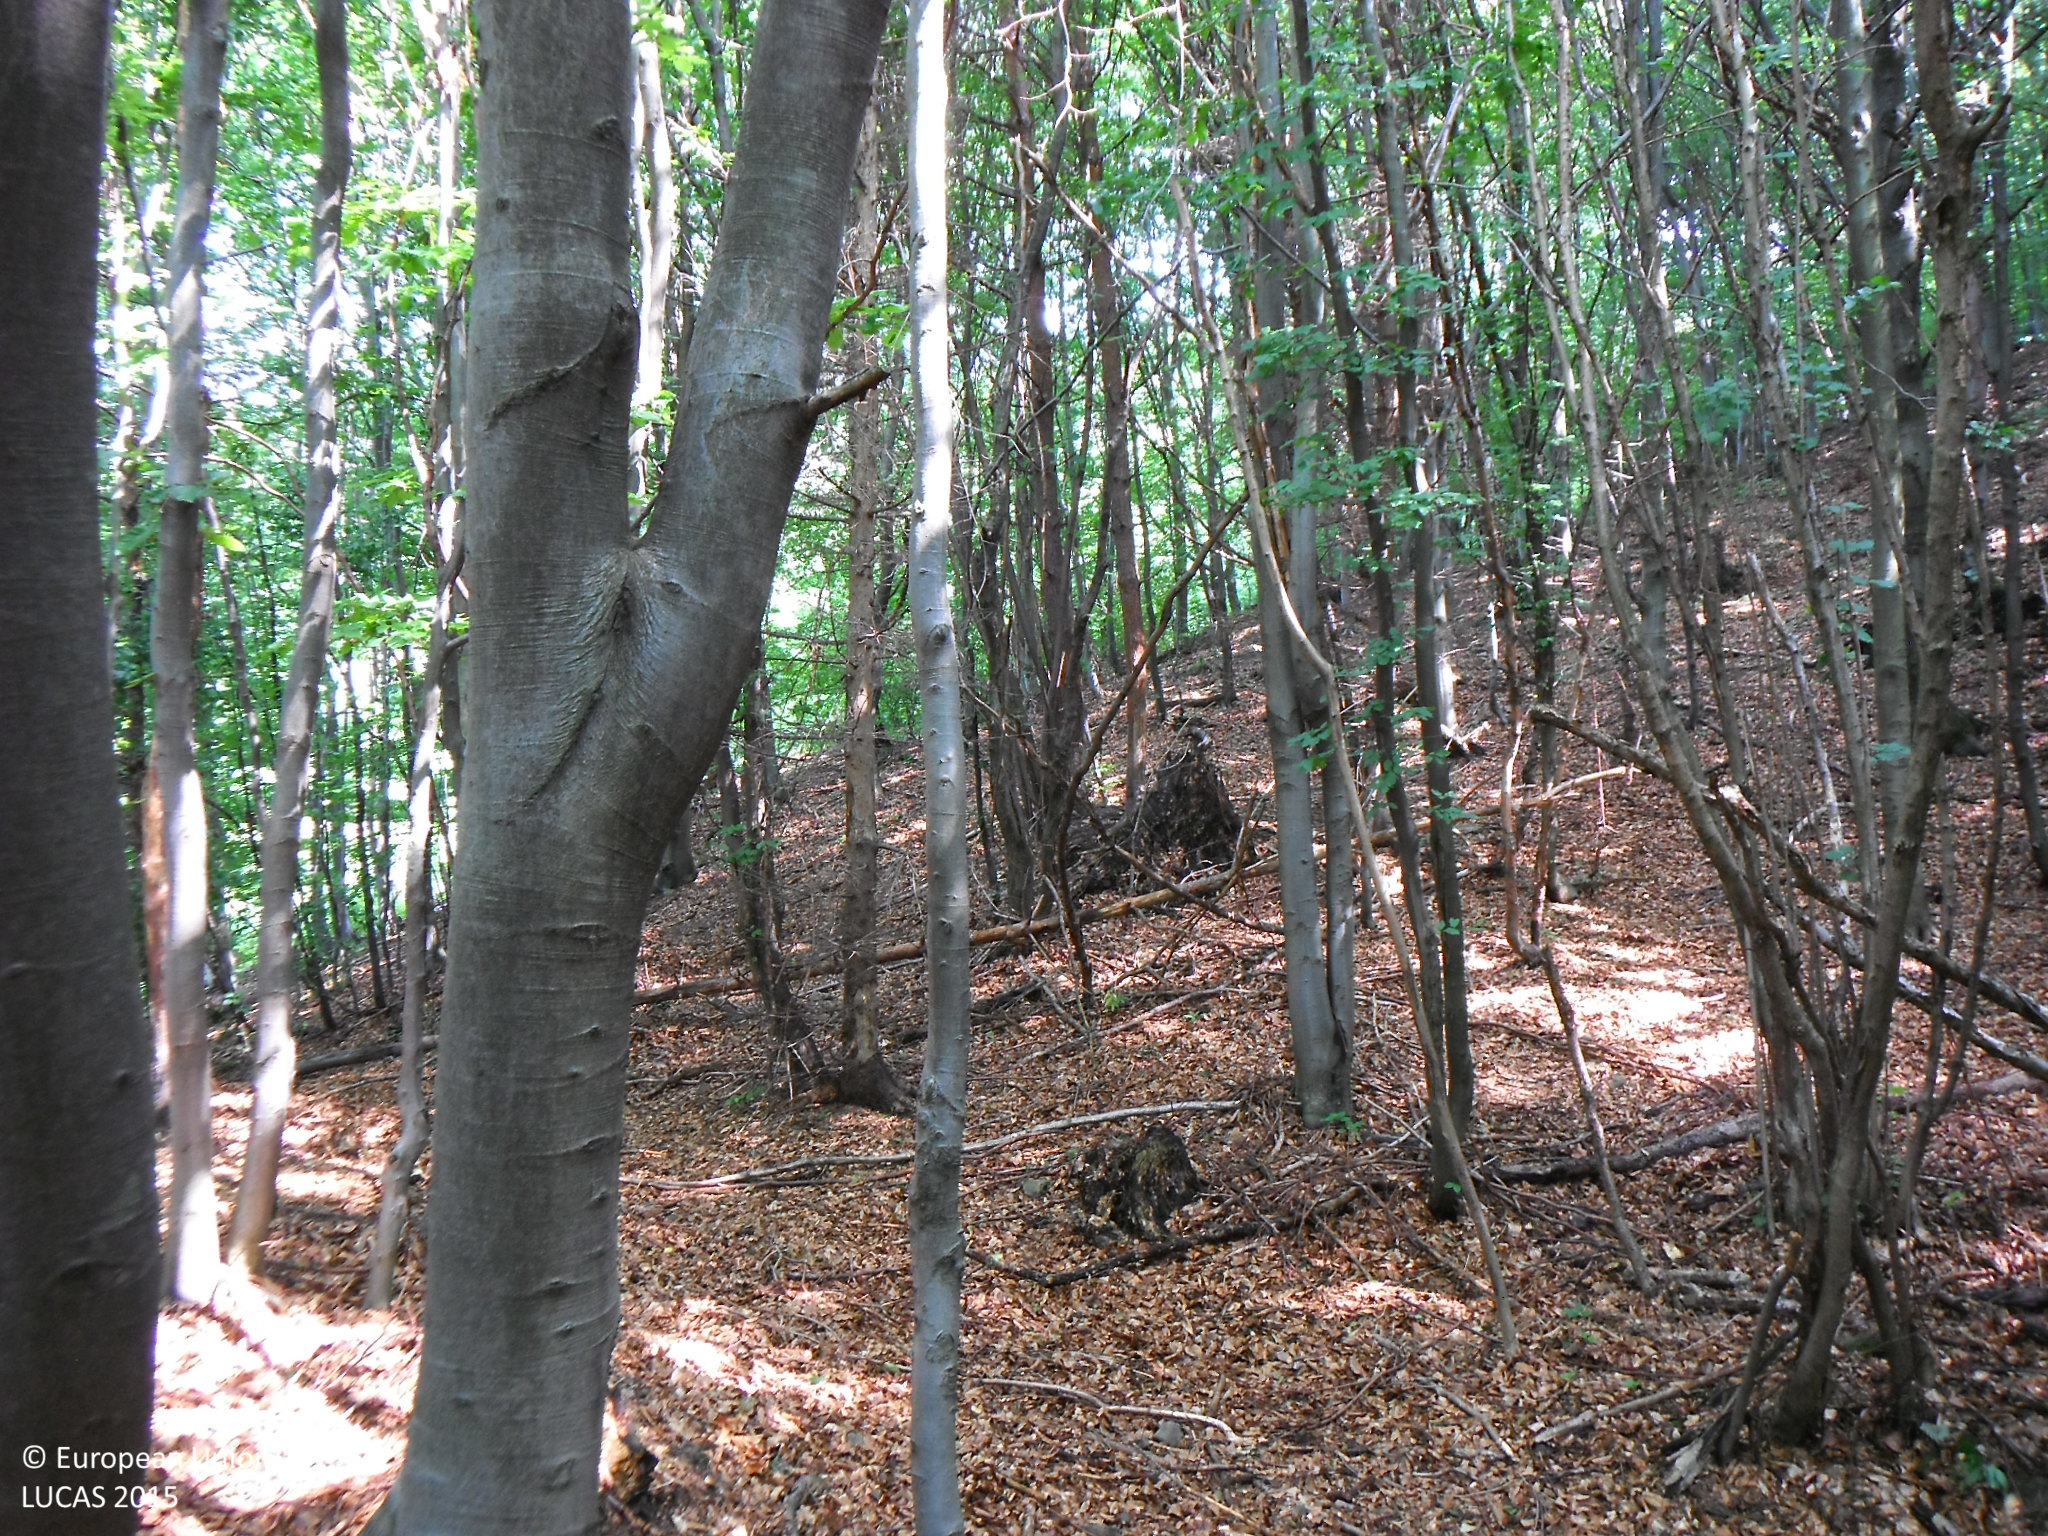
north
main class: Woodland
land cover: Broadleaved woodland
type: beech forest
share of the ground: > 75 %
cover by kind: broadleaved forest trees 85 %, coniferous forest trees 15 %
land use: Forestry
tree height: > 5 m
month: July
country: SK
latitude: 49.4225
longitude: 21.2821
